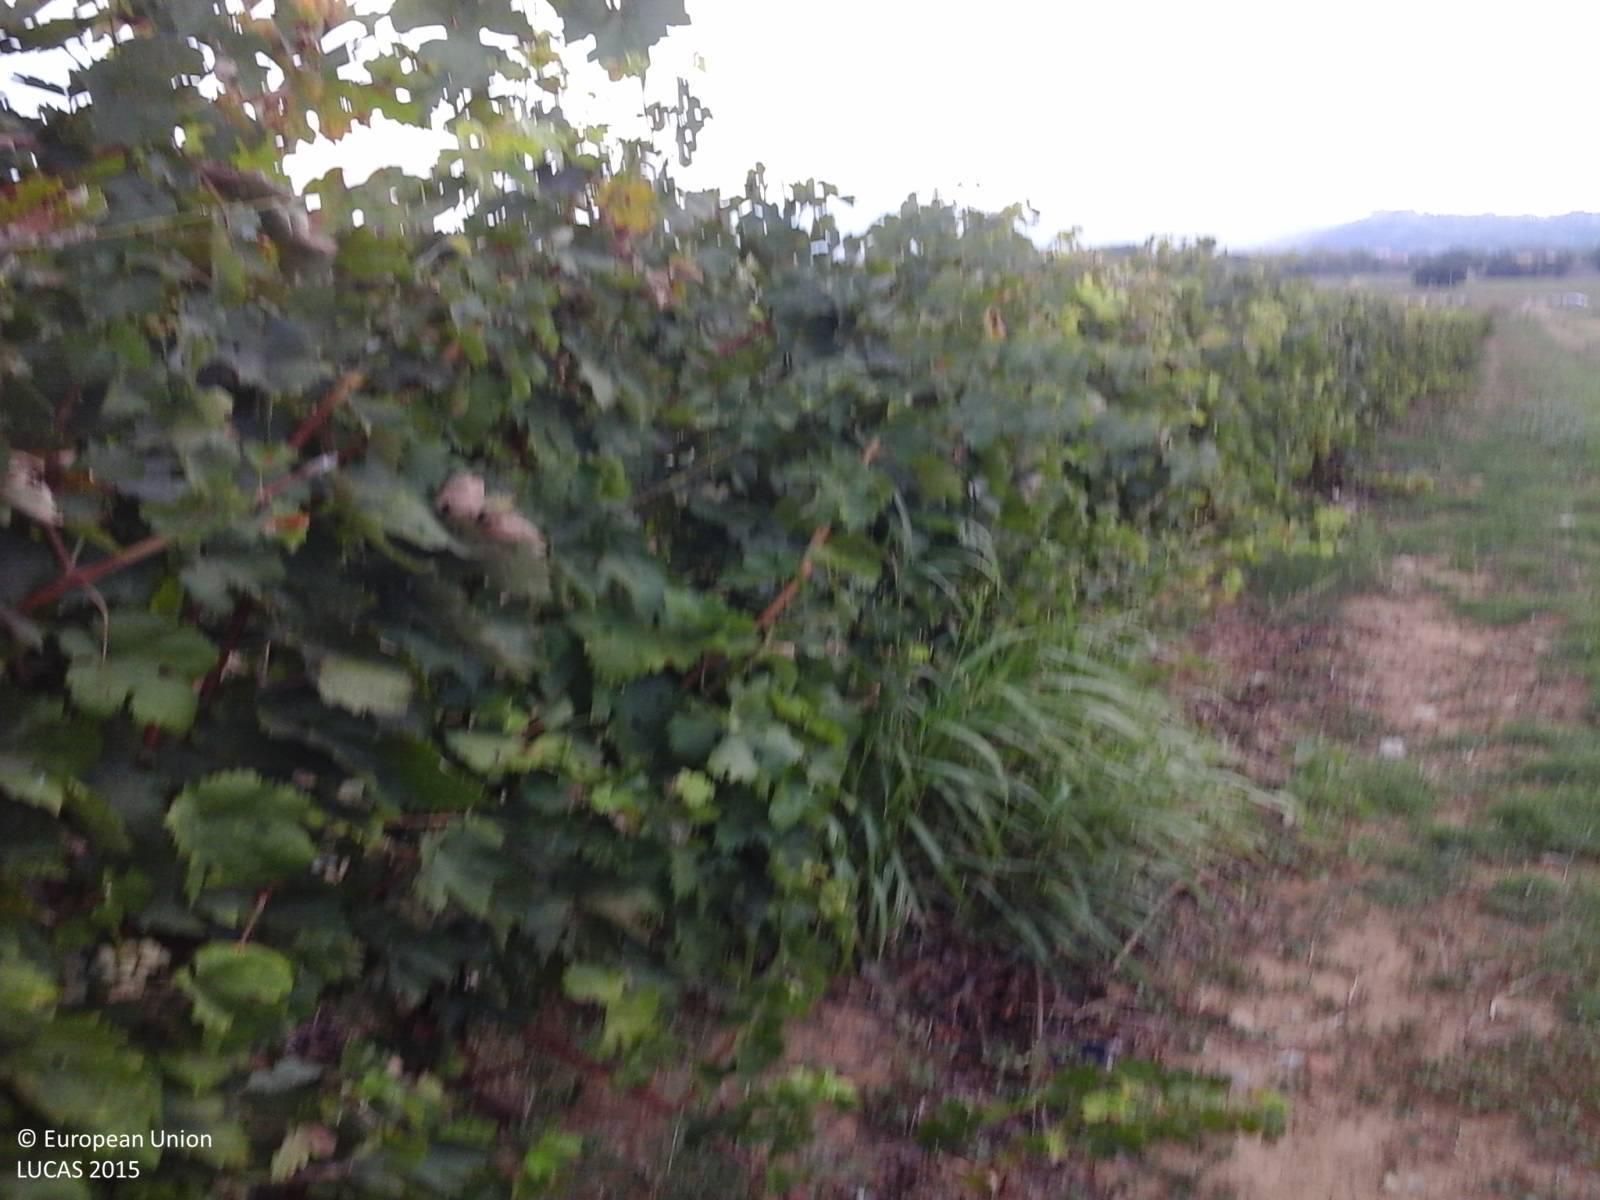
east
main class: Cropland
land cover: Vineyards
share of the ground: 25 - 50 %
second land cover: Grassland without tree/shrub cover
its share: 50 - 75 %
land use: Agriculture (excluding fallow land and kitchen gardens)
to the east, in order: Vineyards; Grassland without tree/shrub cover; Lucerne; Ditches and canals
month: September
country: IT
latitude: 43.1360
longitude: 12.1942
